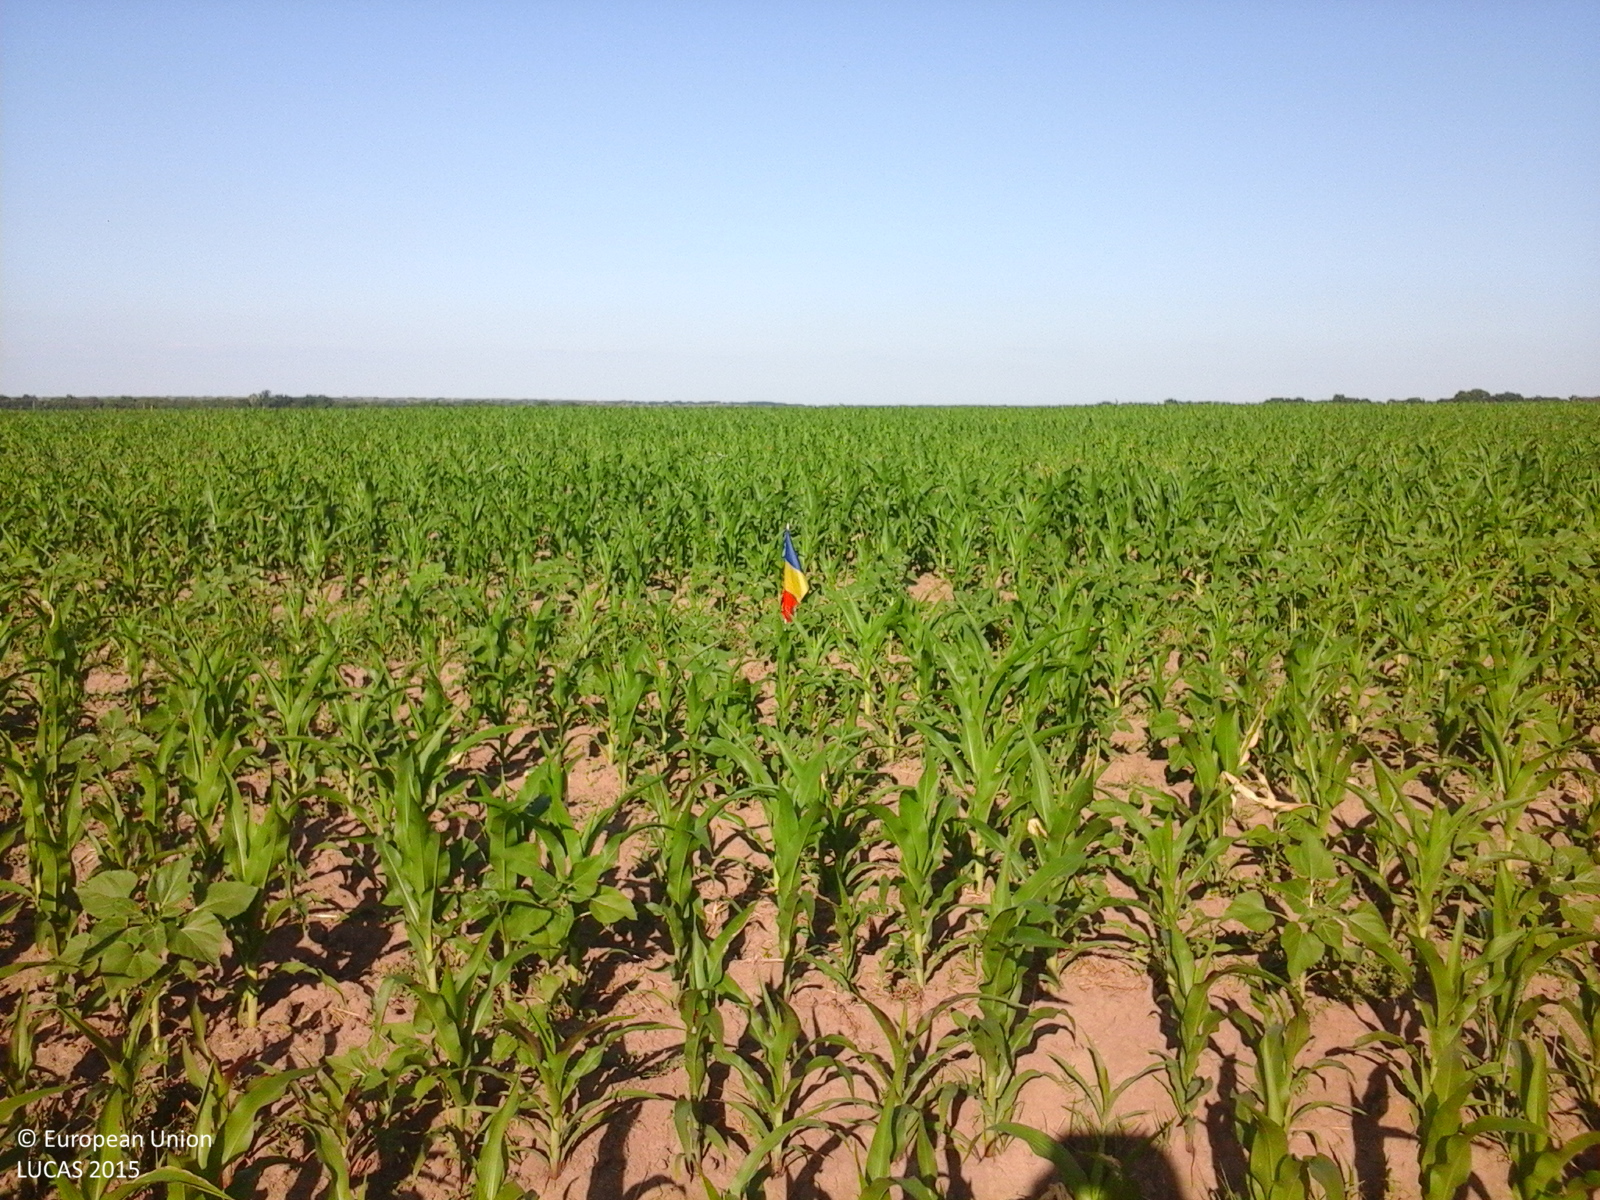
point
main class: Cropland
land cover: Maize
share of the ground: 50 - 75 %
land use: Agriculture (excluding fallow land and kitchen gardens)
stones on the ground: < 10 %
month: June
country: RO
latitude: 47.1162
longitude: 27.3091
